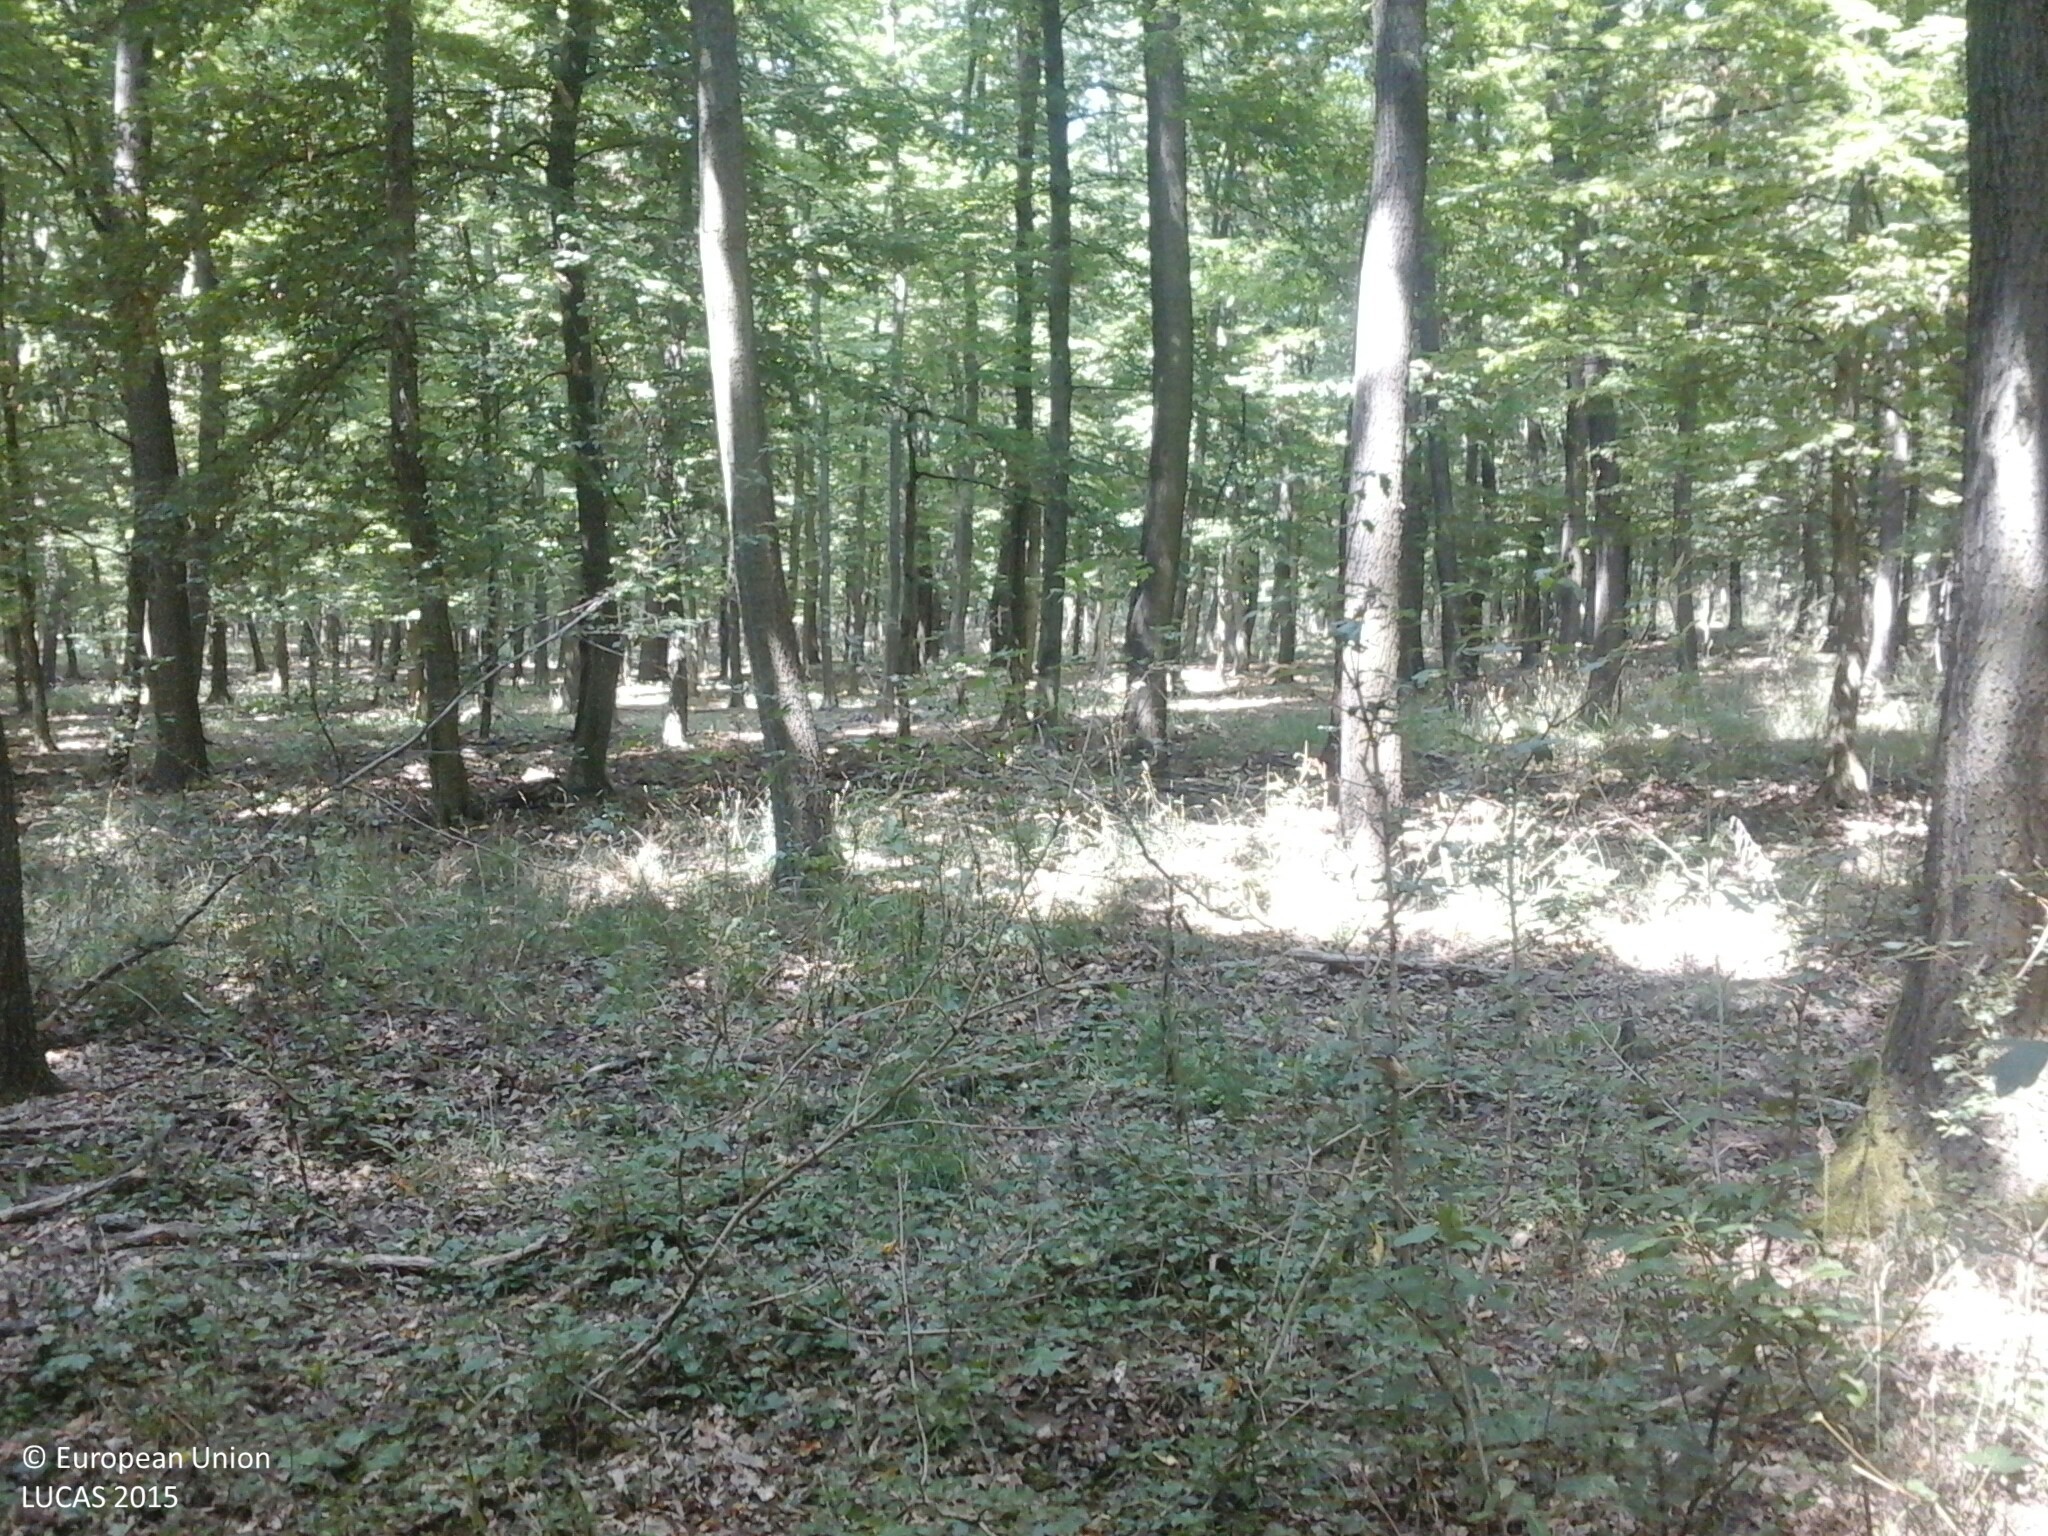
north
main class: Woodland
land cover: Broadleaved woodland
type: acidophilous oak and oak-birch forest
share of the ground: > 75 %
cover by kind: broadleaved forest trees 100 %
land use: Forestry
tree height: > 5 m
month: August
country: HU
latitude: 47.4597
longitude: 18.2764
